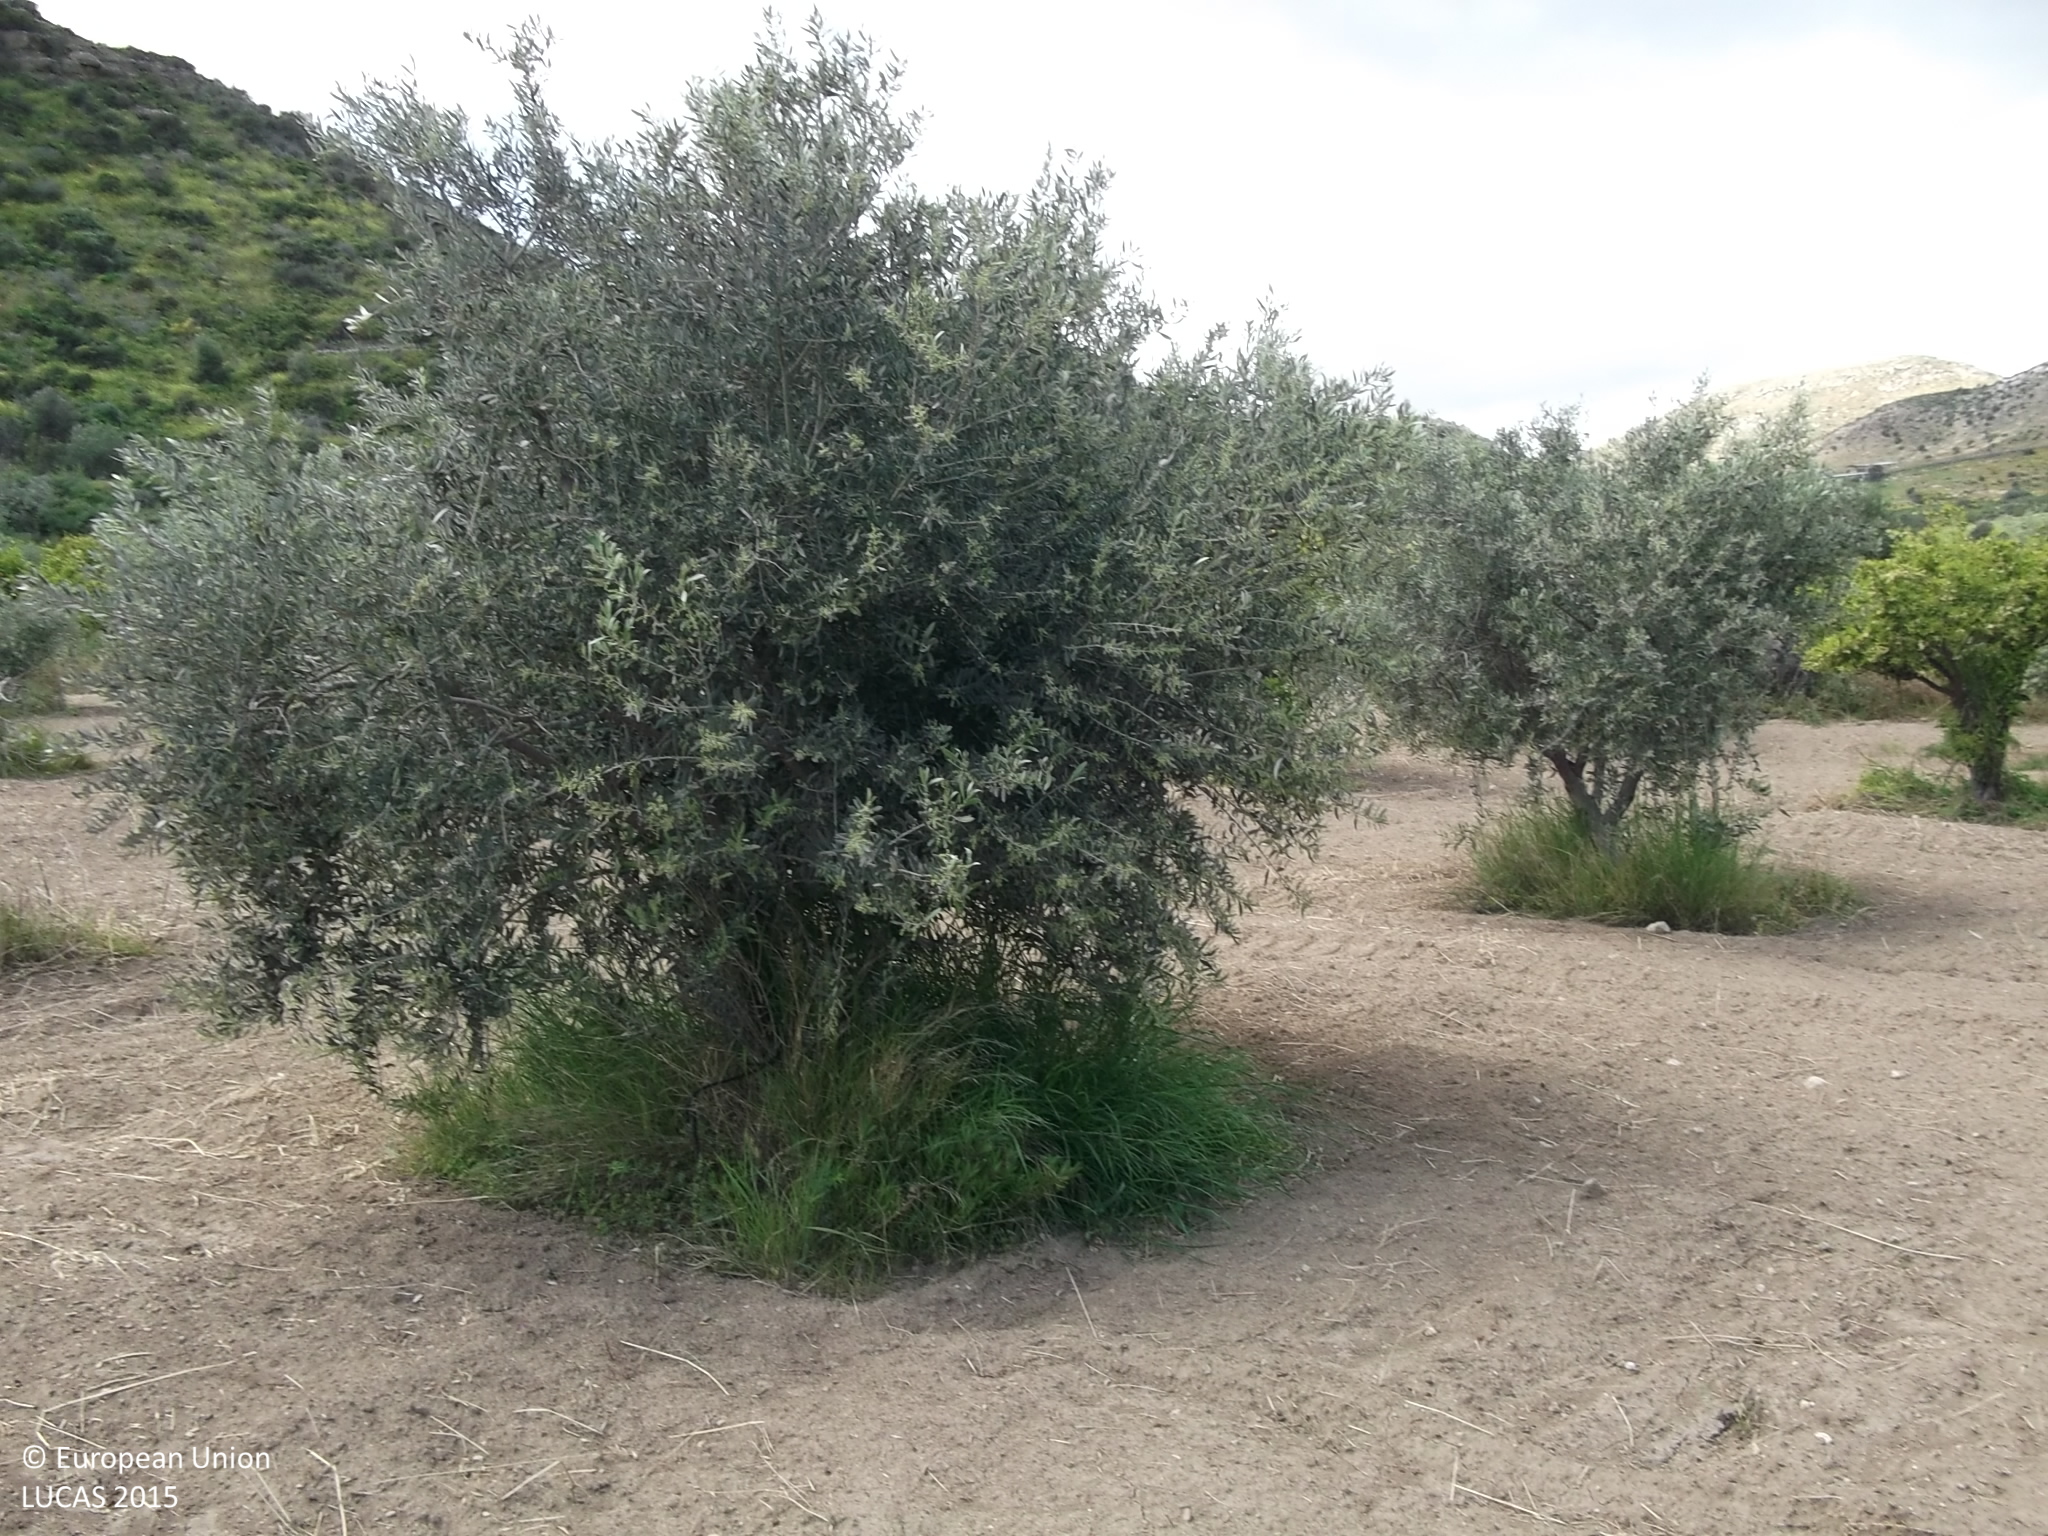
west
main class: Cropland
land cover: Olive groves
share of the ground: 25 - 50 %
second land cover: Other bare soil
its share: > 75 %
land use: Agriculture (excluding fallow land and kitchen gardens)
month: April
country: CY
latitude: 34.7660
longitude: 33.3990
